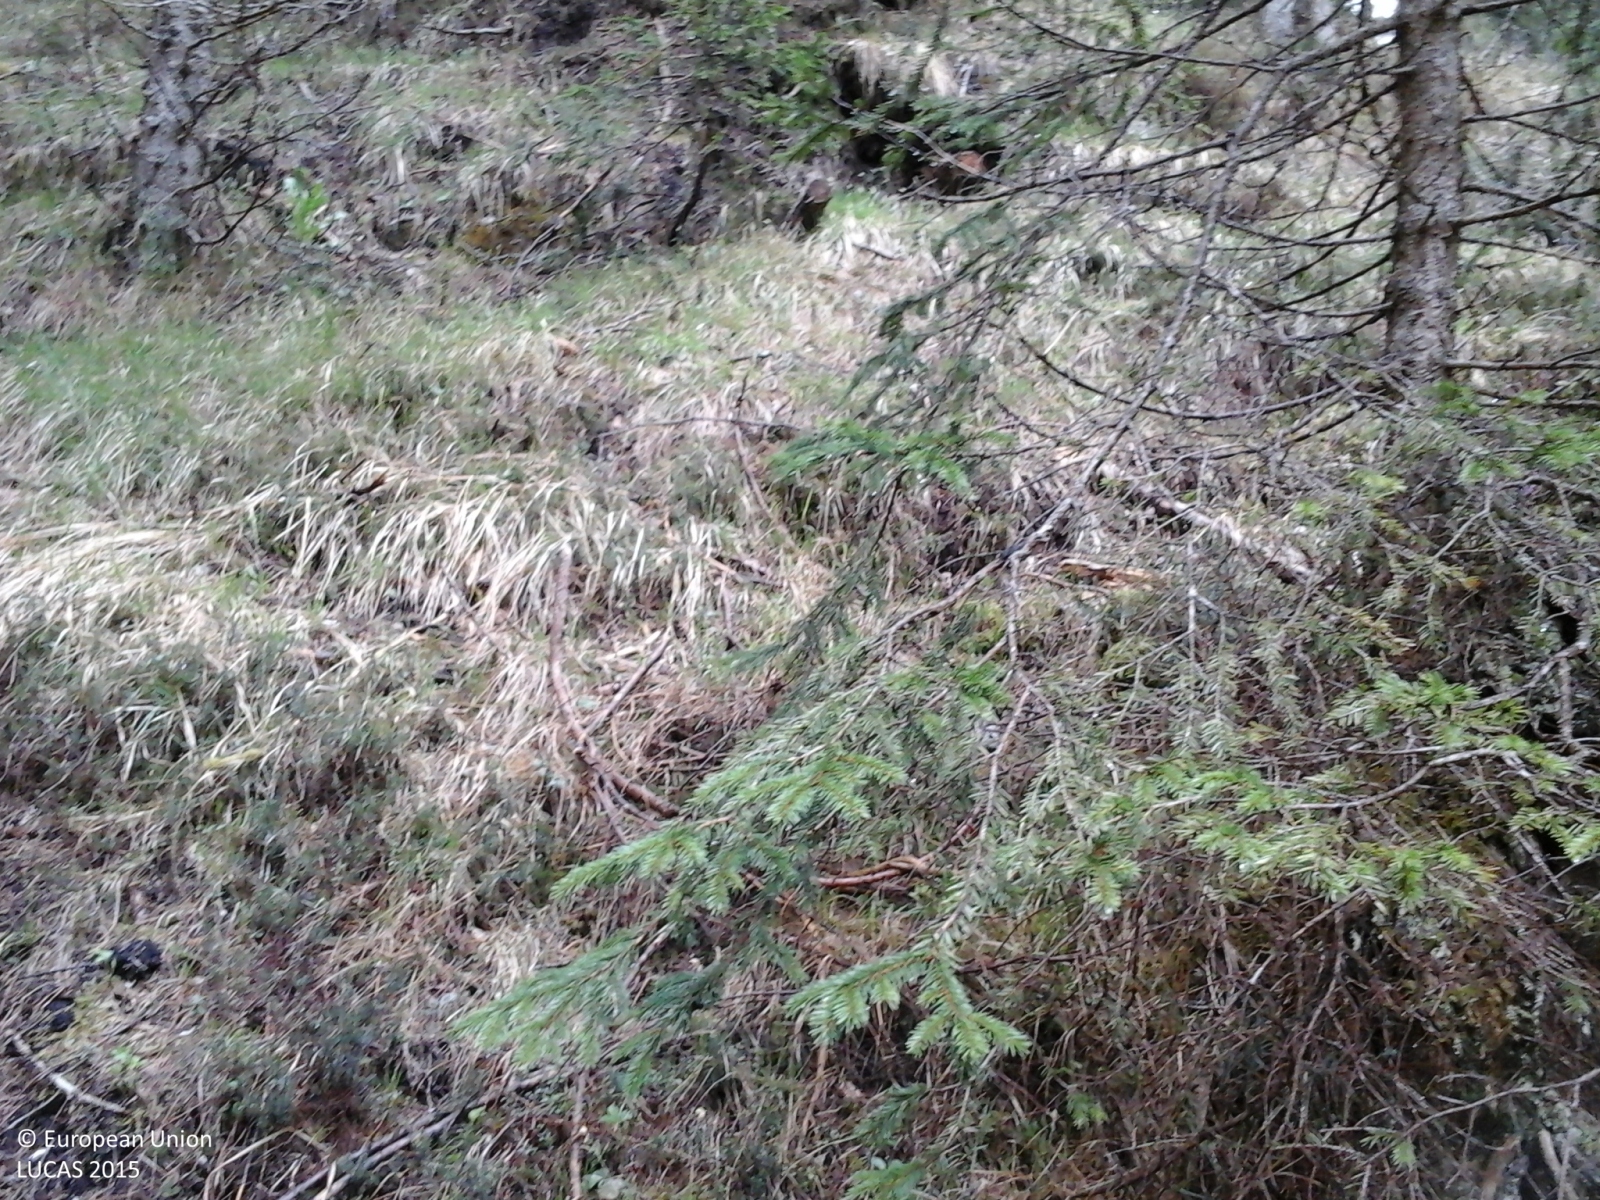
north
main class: Woodland
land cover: Spruce dominated coniferous woodland
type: alpine coniferous forest
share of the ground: > 75 %
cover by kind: coniferous forest trees 100 %
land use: Forestry
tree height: > 5 m
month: May
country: IT
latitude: 46.5073
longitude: 11.1324
